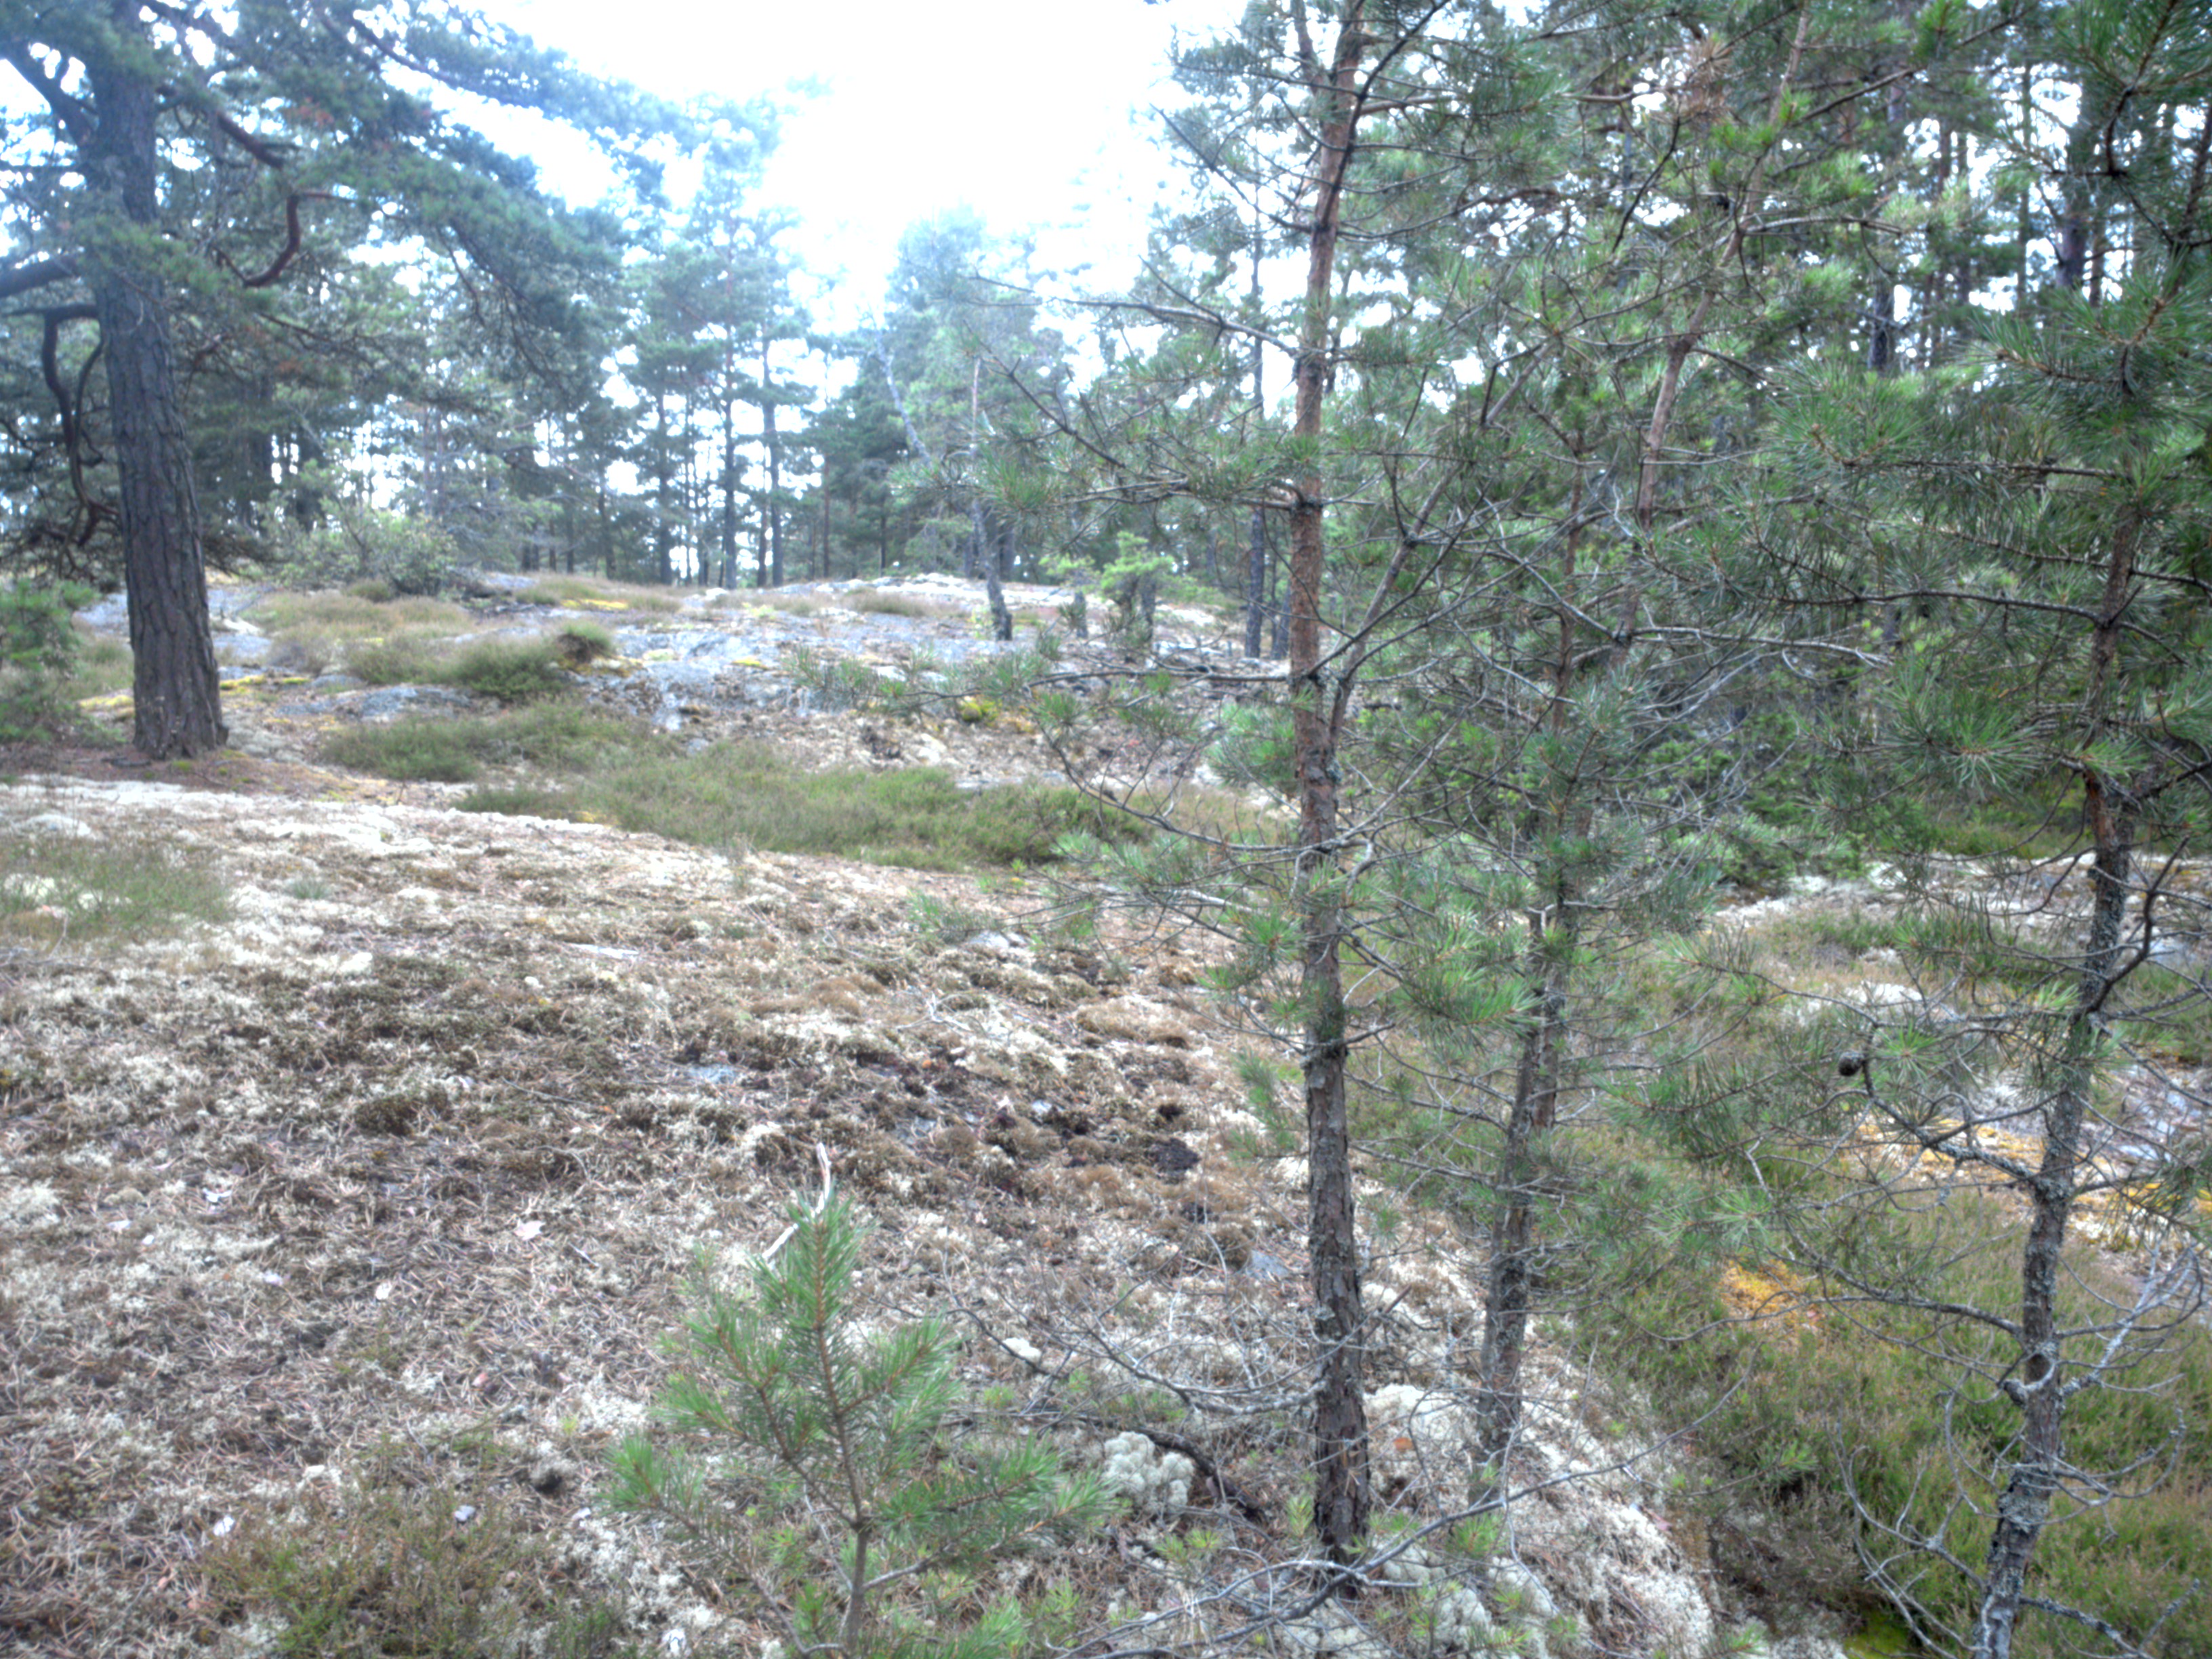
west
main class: Woodland
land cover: Pine dominated coniferous woodland
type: boreal forest
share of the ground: 25 - 50 %
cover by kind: shrubs 35 %, lichens and mosses 35 %, coniferous forest trees 30 %
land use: Forestry
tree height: > 5 m
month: July
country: SE
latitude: 59.0917
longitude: 18.1862
